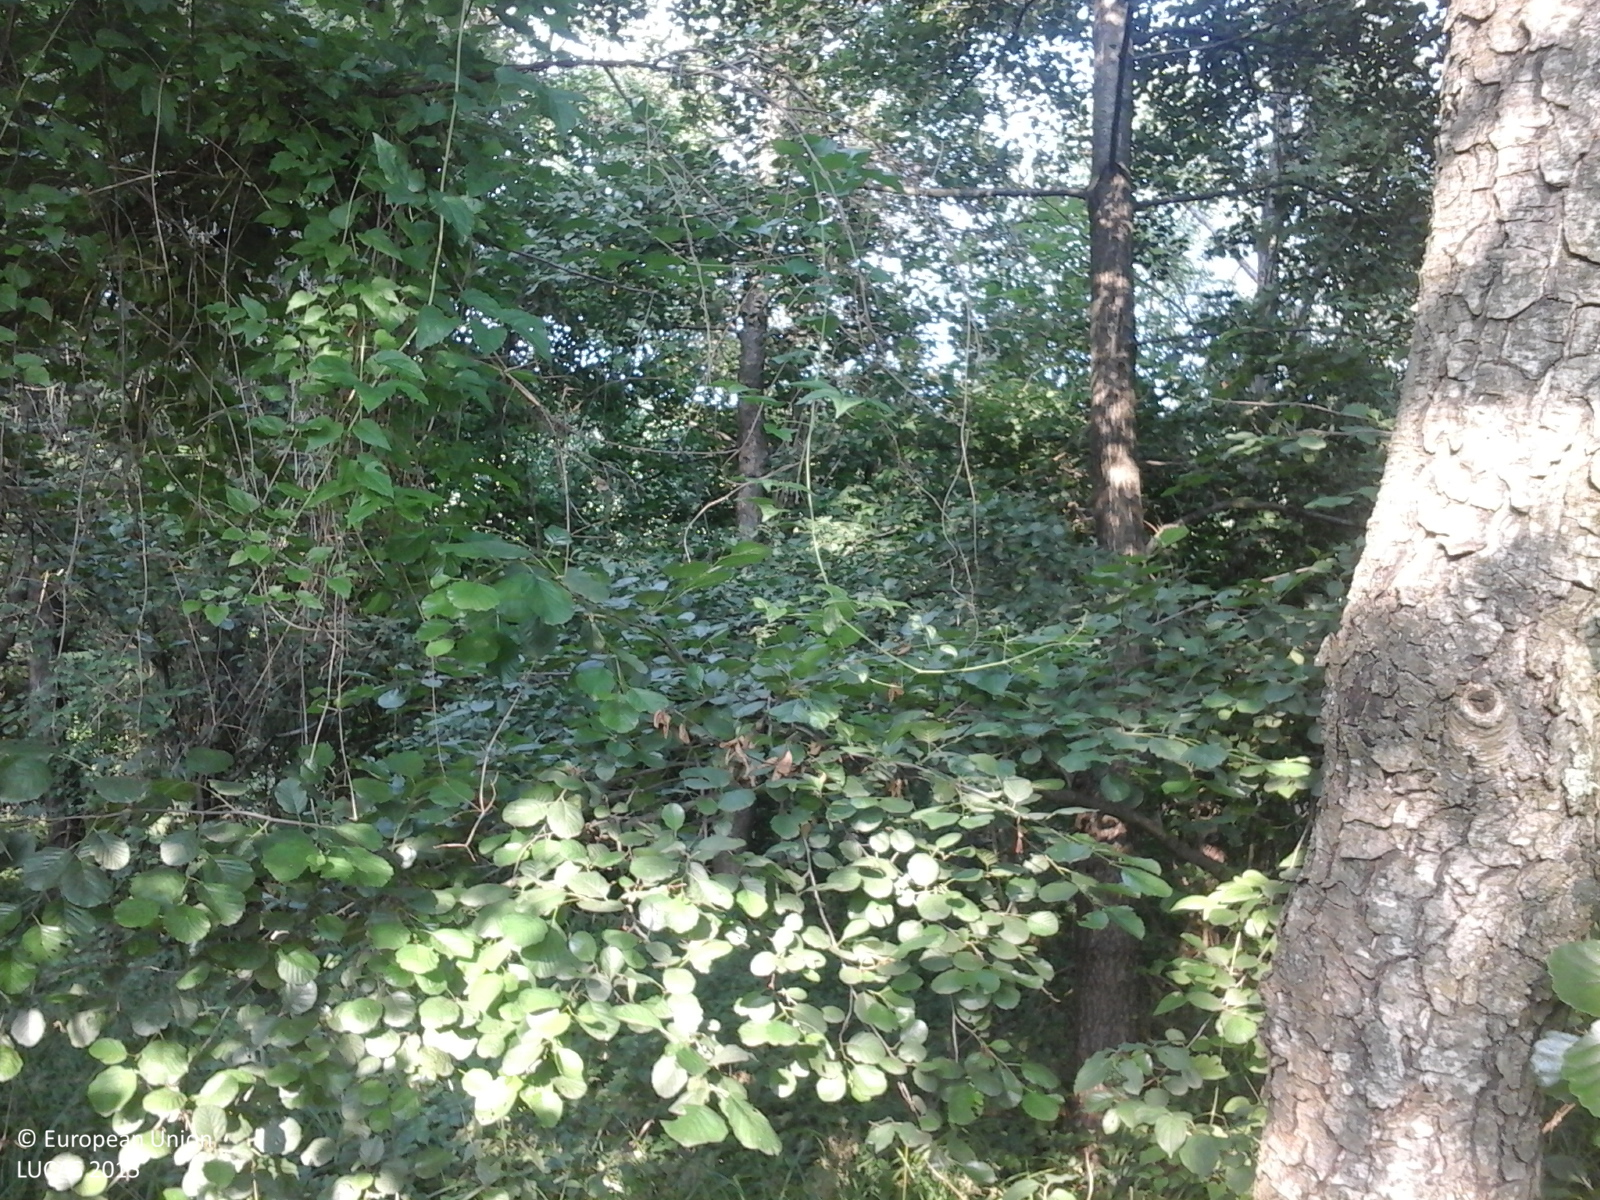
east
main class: Woodland
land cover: Broadleaved woodland
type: beech forest
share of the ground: > 75 %
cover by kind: broadleaved forest trees 100 %
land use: Forestry
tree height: > 5 m
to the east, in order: Broadleaved woodland; Inland fresh running water; Broadleaved woodland; Grass margins; Tracks; Grass margins; Maize; Broadleaved woodland
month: July
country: RO
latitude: 45.0937
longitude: 24.5500
